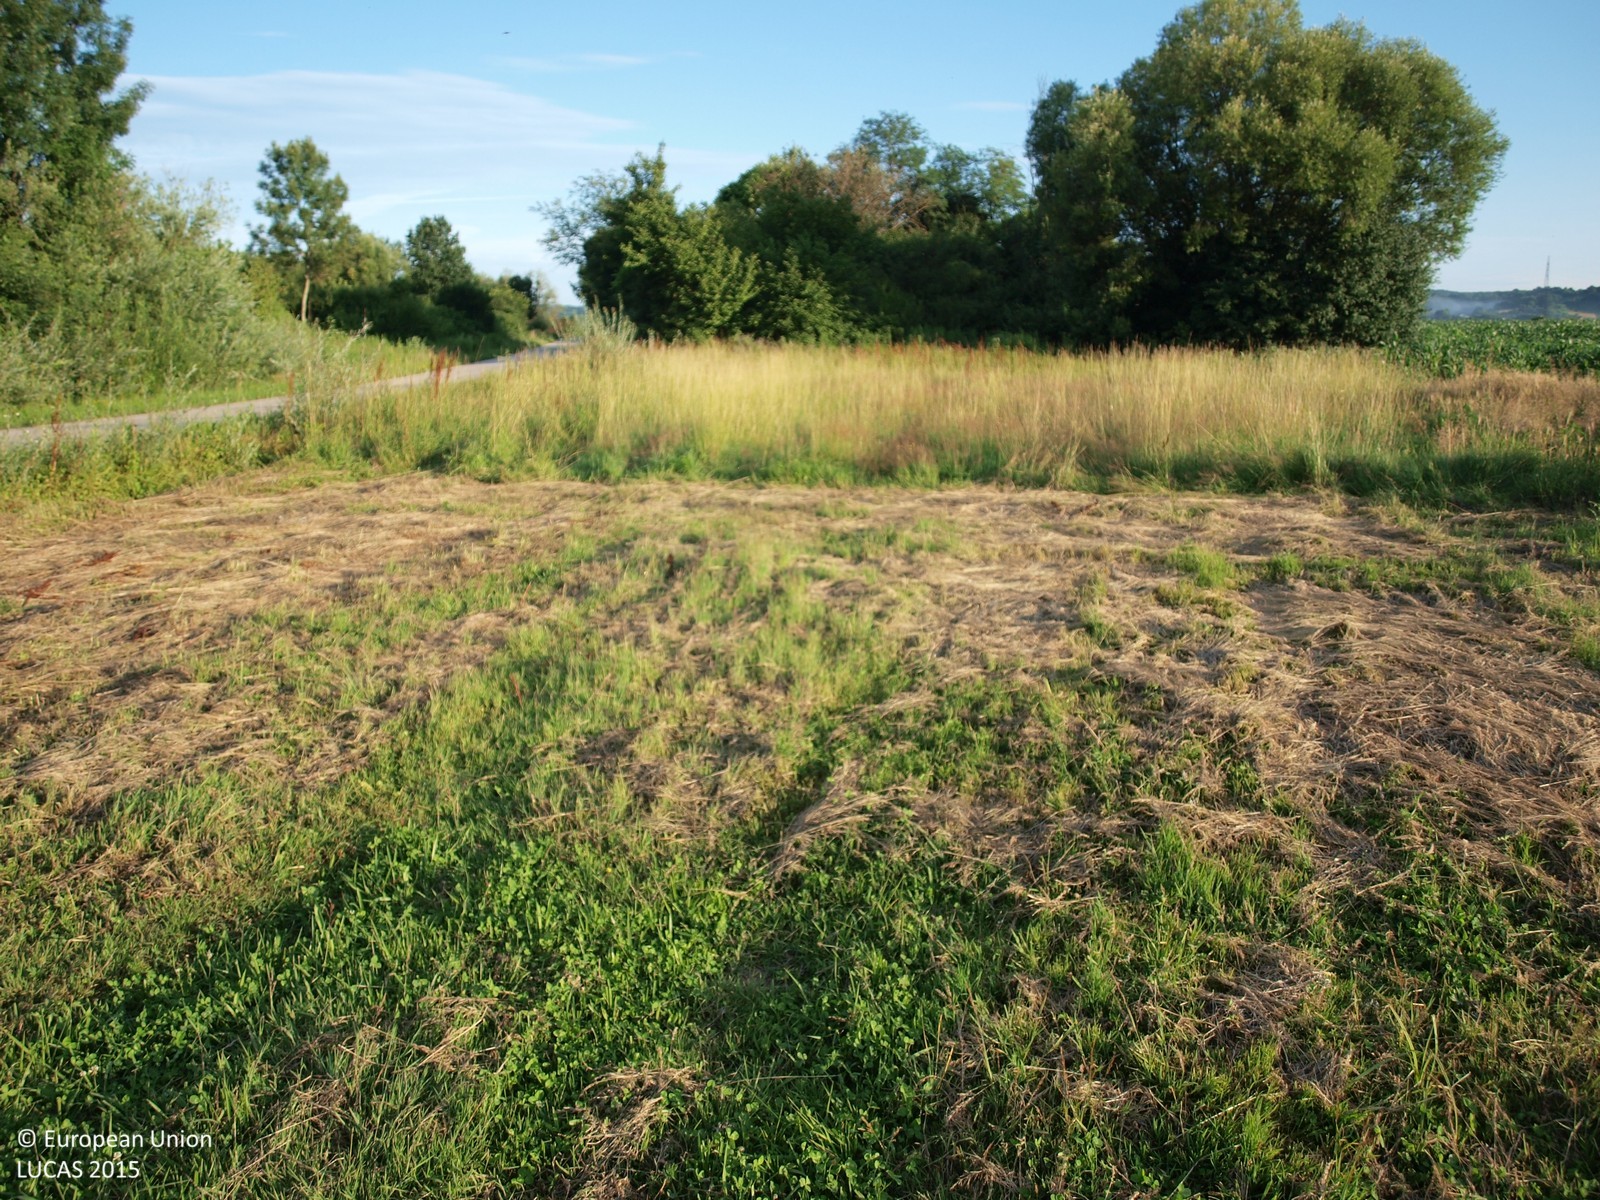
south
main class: Grassland
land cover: Grassland without tree/shrub cover
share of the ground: > 75 %
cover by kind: herbaceous plants 100 %
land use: Agriculture (excluding fallow land and kitchen gardens)
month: June
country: HR
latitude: 46.2523
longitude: 16.6553
